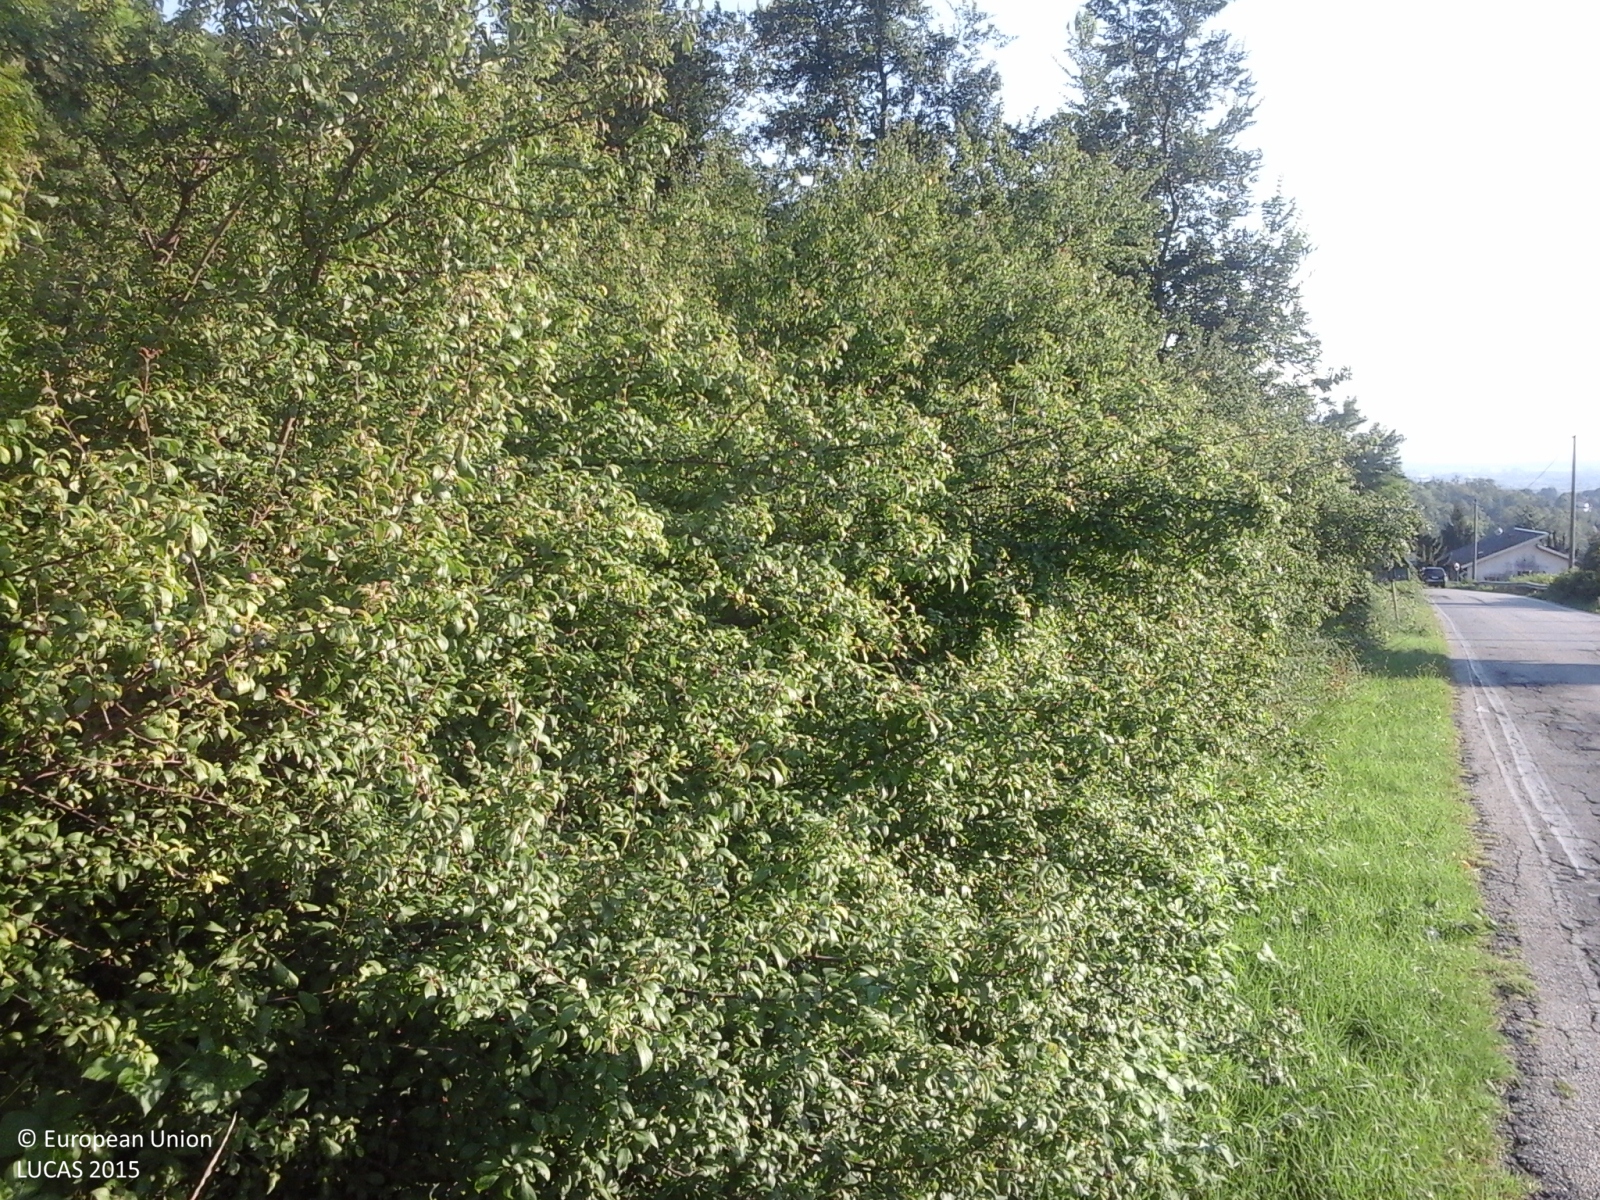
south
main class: Woodland
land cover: Broadleaved woodland
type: thermophilous deciduous forest
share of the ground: > 75 %
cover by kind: broadleaved forest trees 90 %, shrubs 10 %
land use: Semi-natural and natural areas not in use
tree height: > 5 m
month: June
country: IT
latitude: 44.9729
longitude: 8.6459
